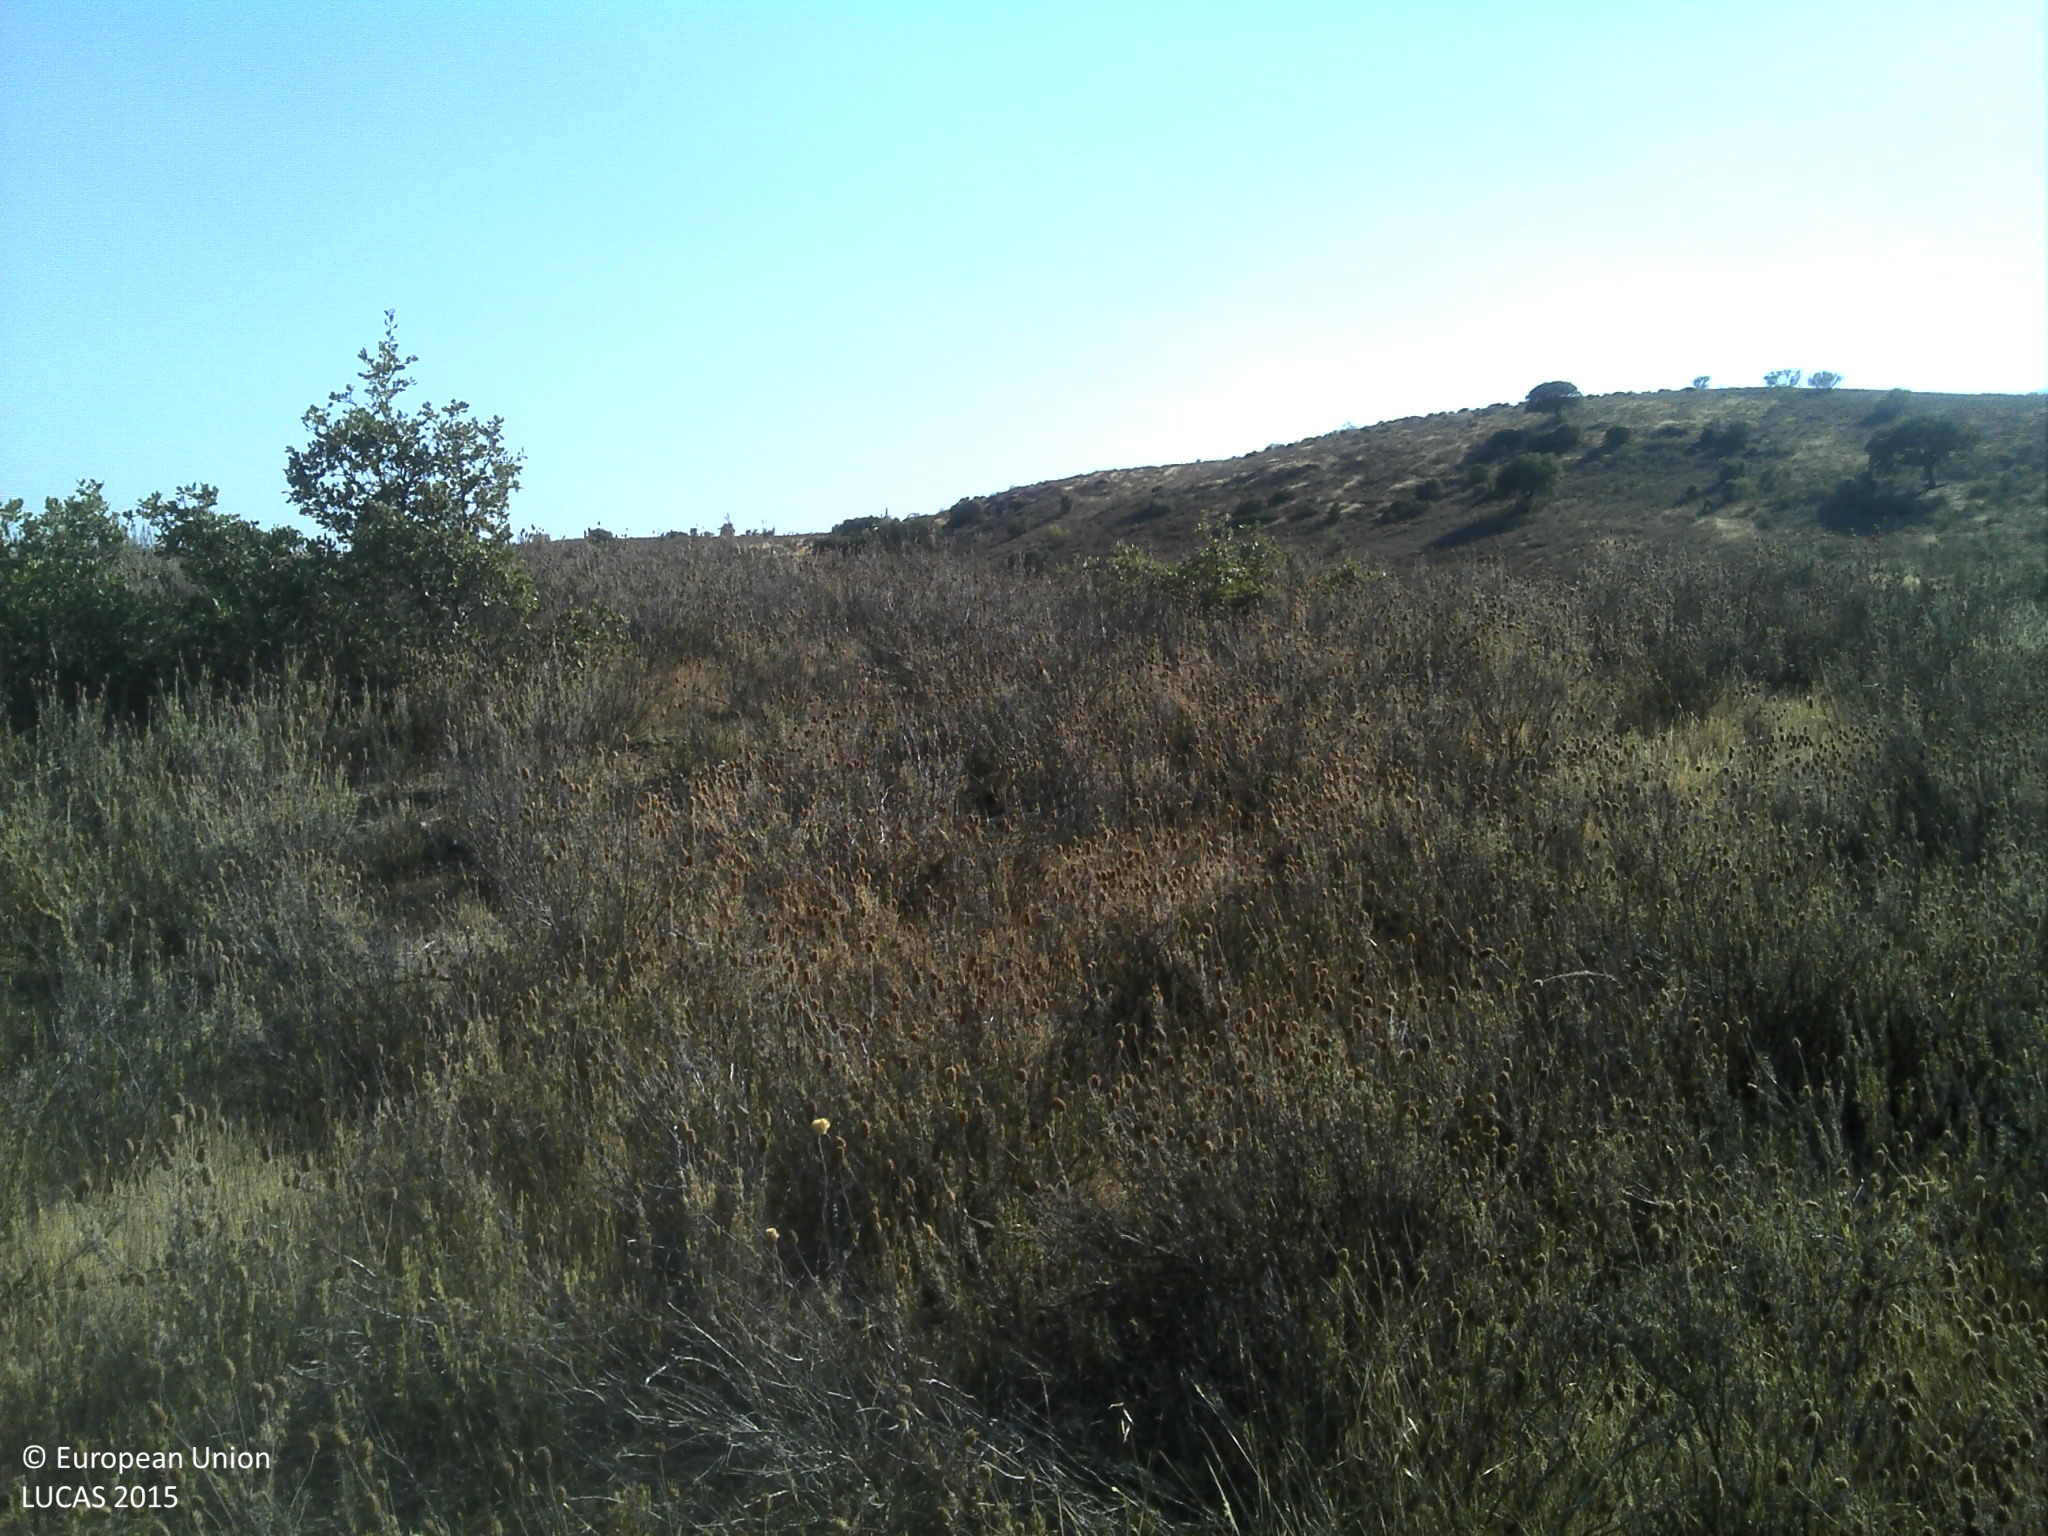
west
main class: Shrubland
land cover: Shrubland without tree cover
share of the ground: 50 - 75 %
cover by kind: shrubs 70 %, herbaceous plants 15 %, unconsolidated bare surface 10 %
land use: Abandoned areas
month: June
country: PT
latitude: 39.7304
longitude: -7.2068
